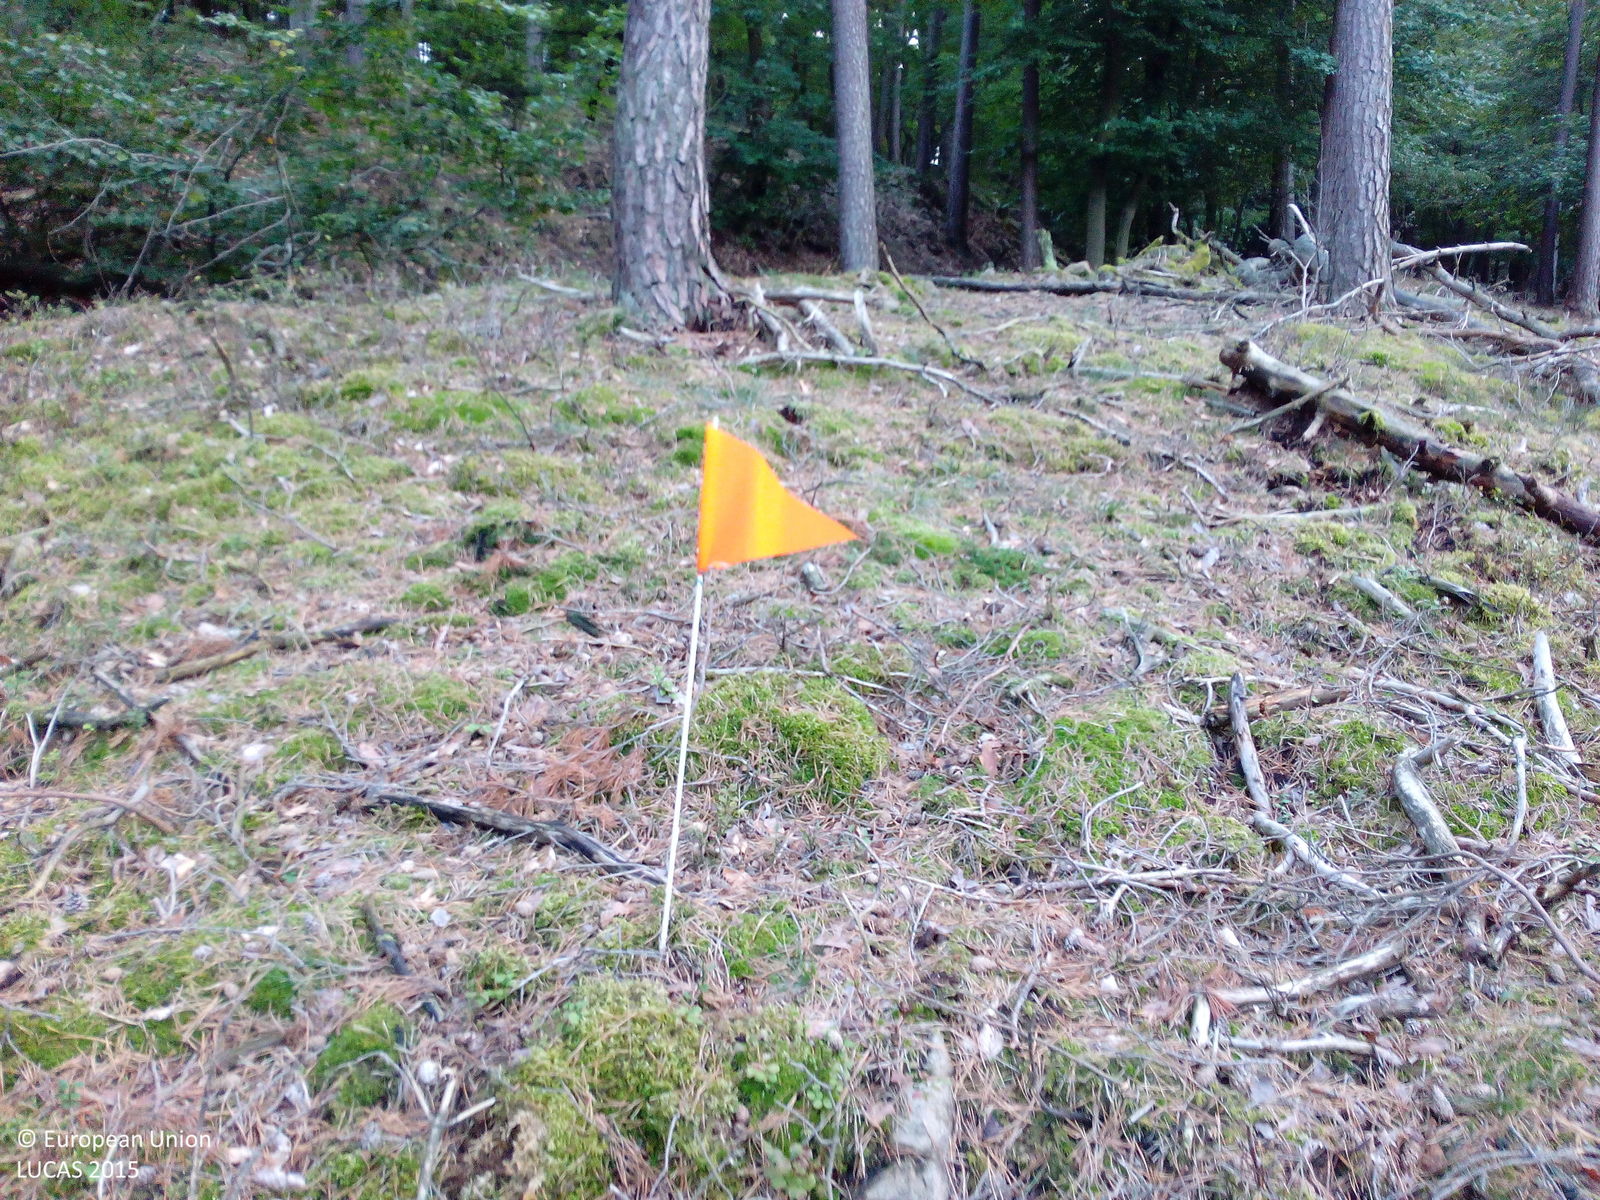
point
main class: Woodland
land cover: Pine dominated coniferous woodland
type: hemiboreal forest and nemoral coniferous forest and mixed broadleaved-coniferous forest
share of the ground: > 75 %
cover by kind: coniferous forest trees 85 %, broadleaved forest trees 5 %, herbaceous plants 5 %, lichens and mosses 5 %
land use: Forestry
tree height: > 5 m
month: September
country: DE
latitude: 49.3043
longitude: 8.0614
